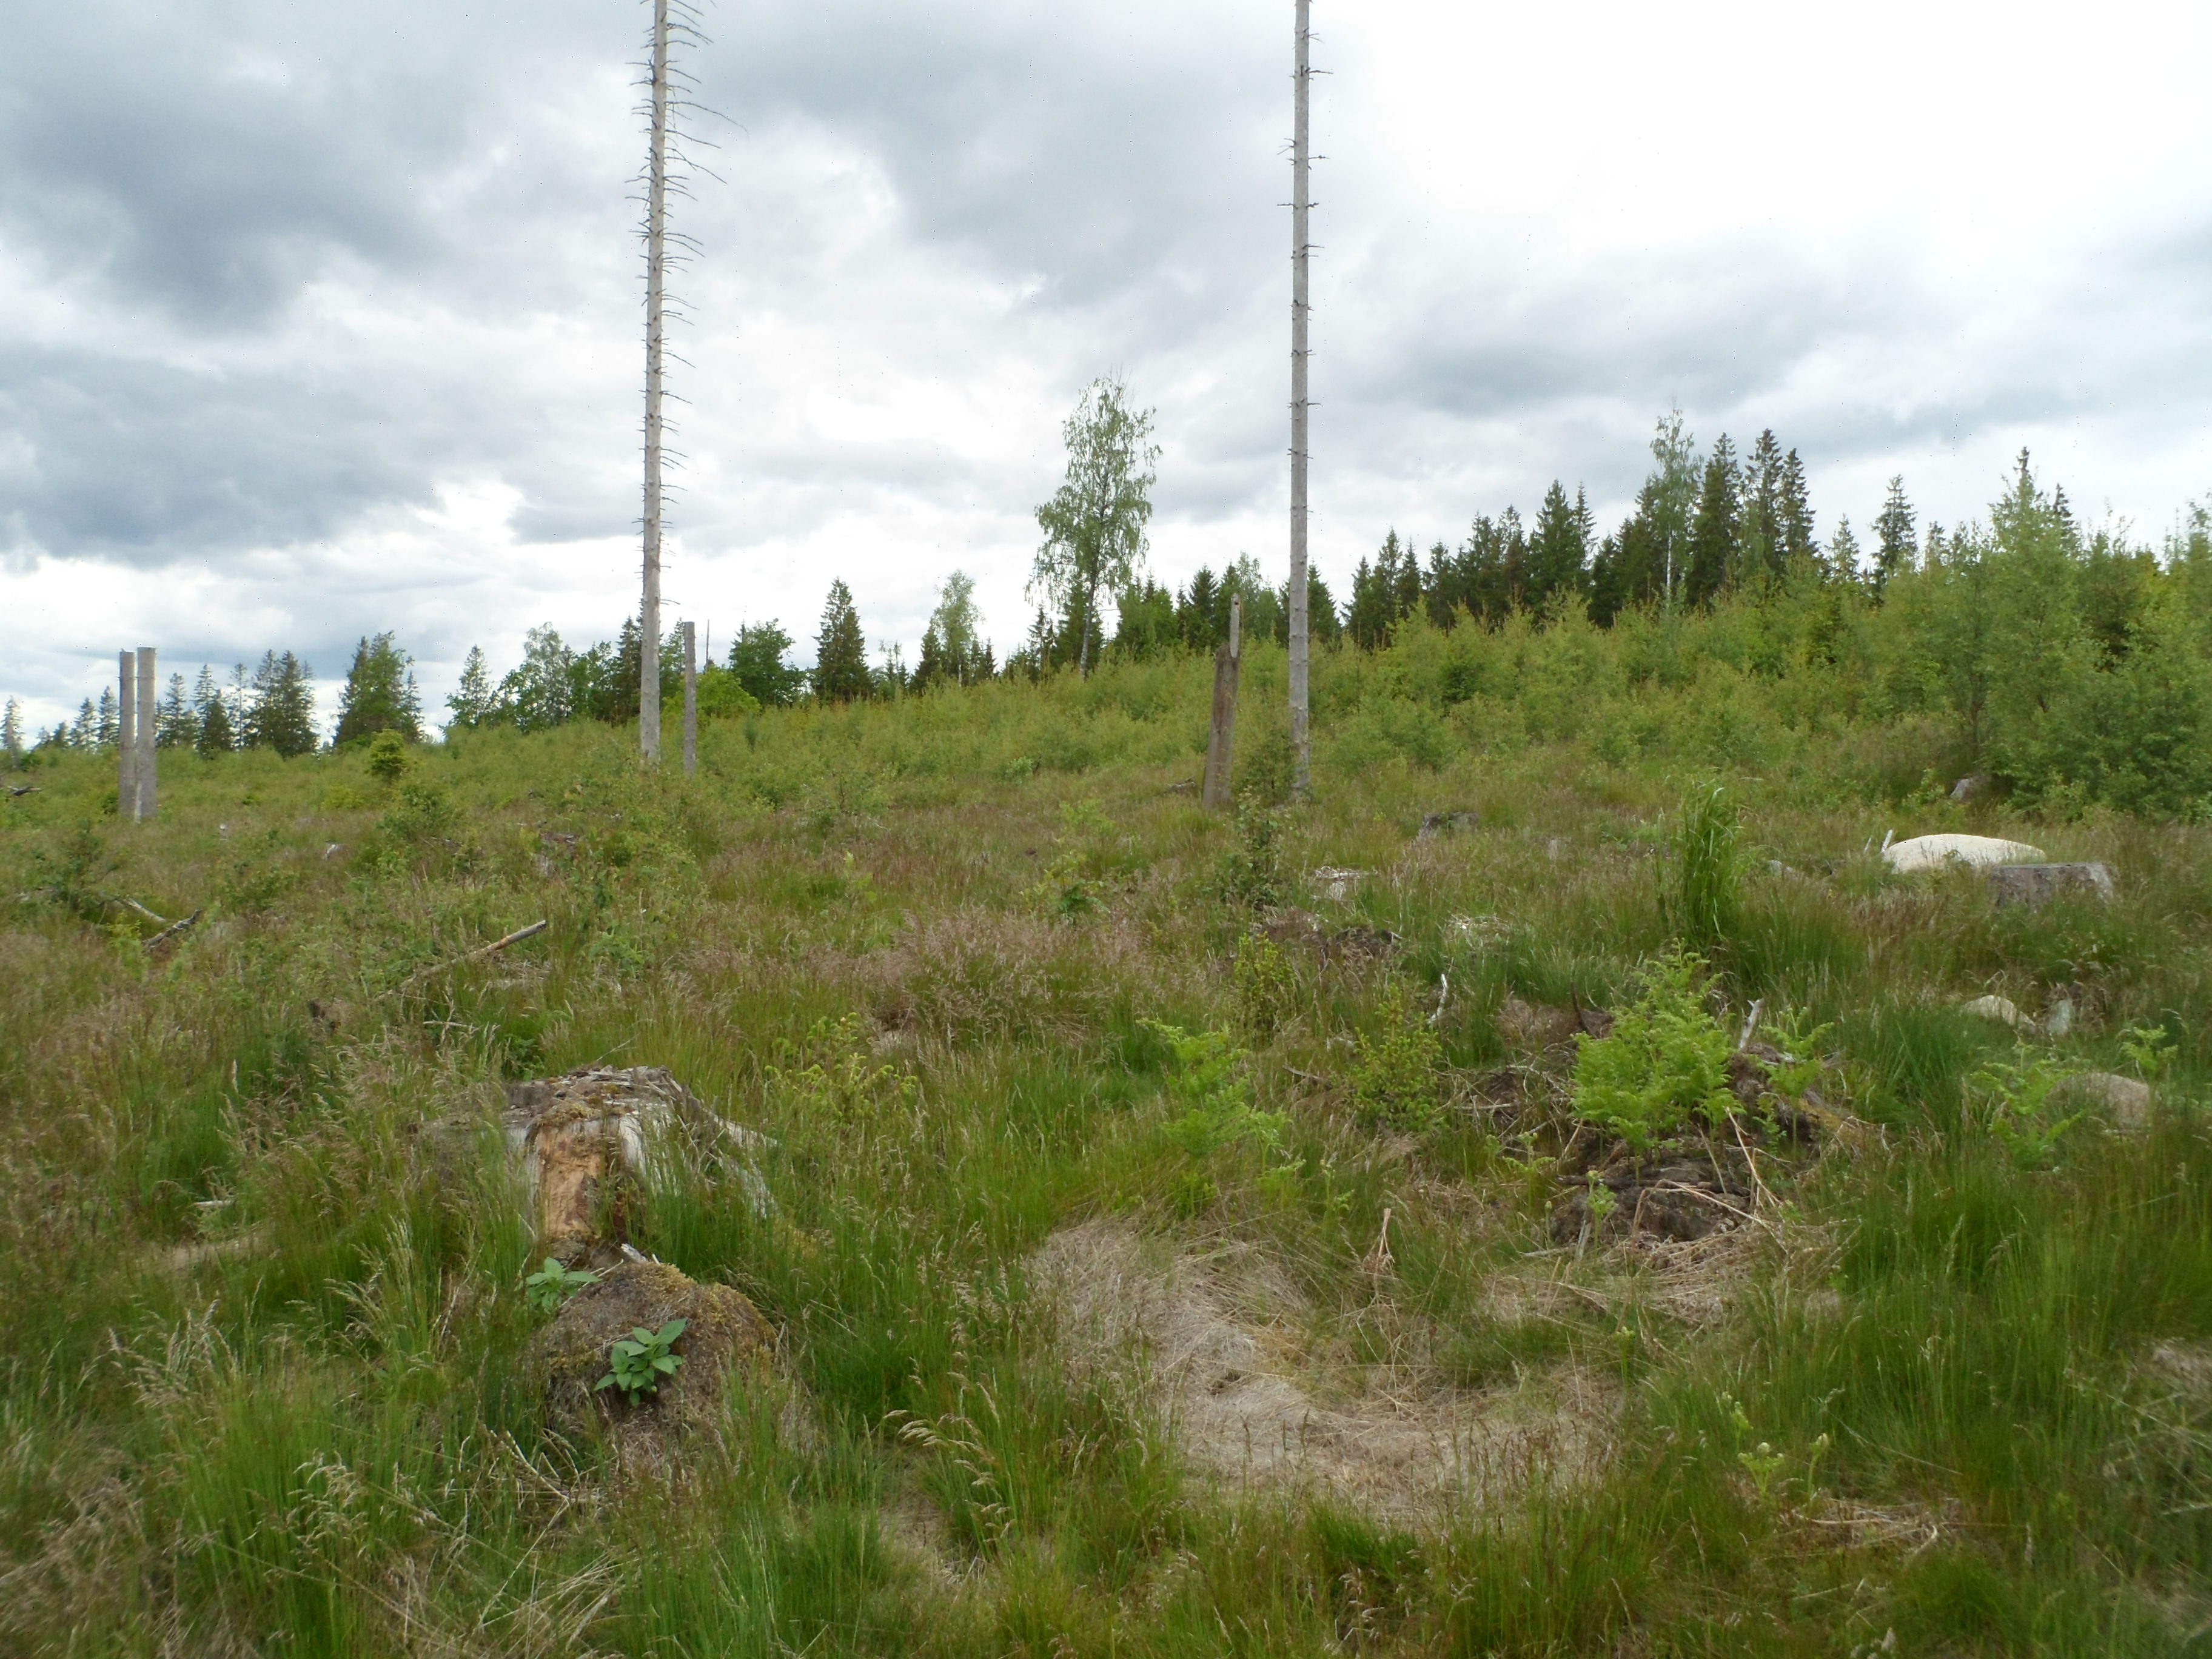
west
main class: Grassland
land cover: Grassland with sparse tree/shrub cover
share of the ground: < 10 %
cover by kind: herbaceous plants 75 %, lichens and mosses 10 %, broadleaved forest trees 5 %, shrubs 5 %, unconsolidated bare surface 5 %
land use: Forestry
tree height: < 5 m
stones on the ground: 25 - 50 %
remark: Clear cut
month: June
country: SE
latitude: 57.3930
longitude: 14.3384
